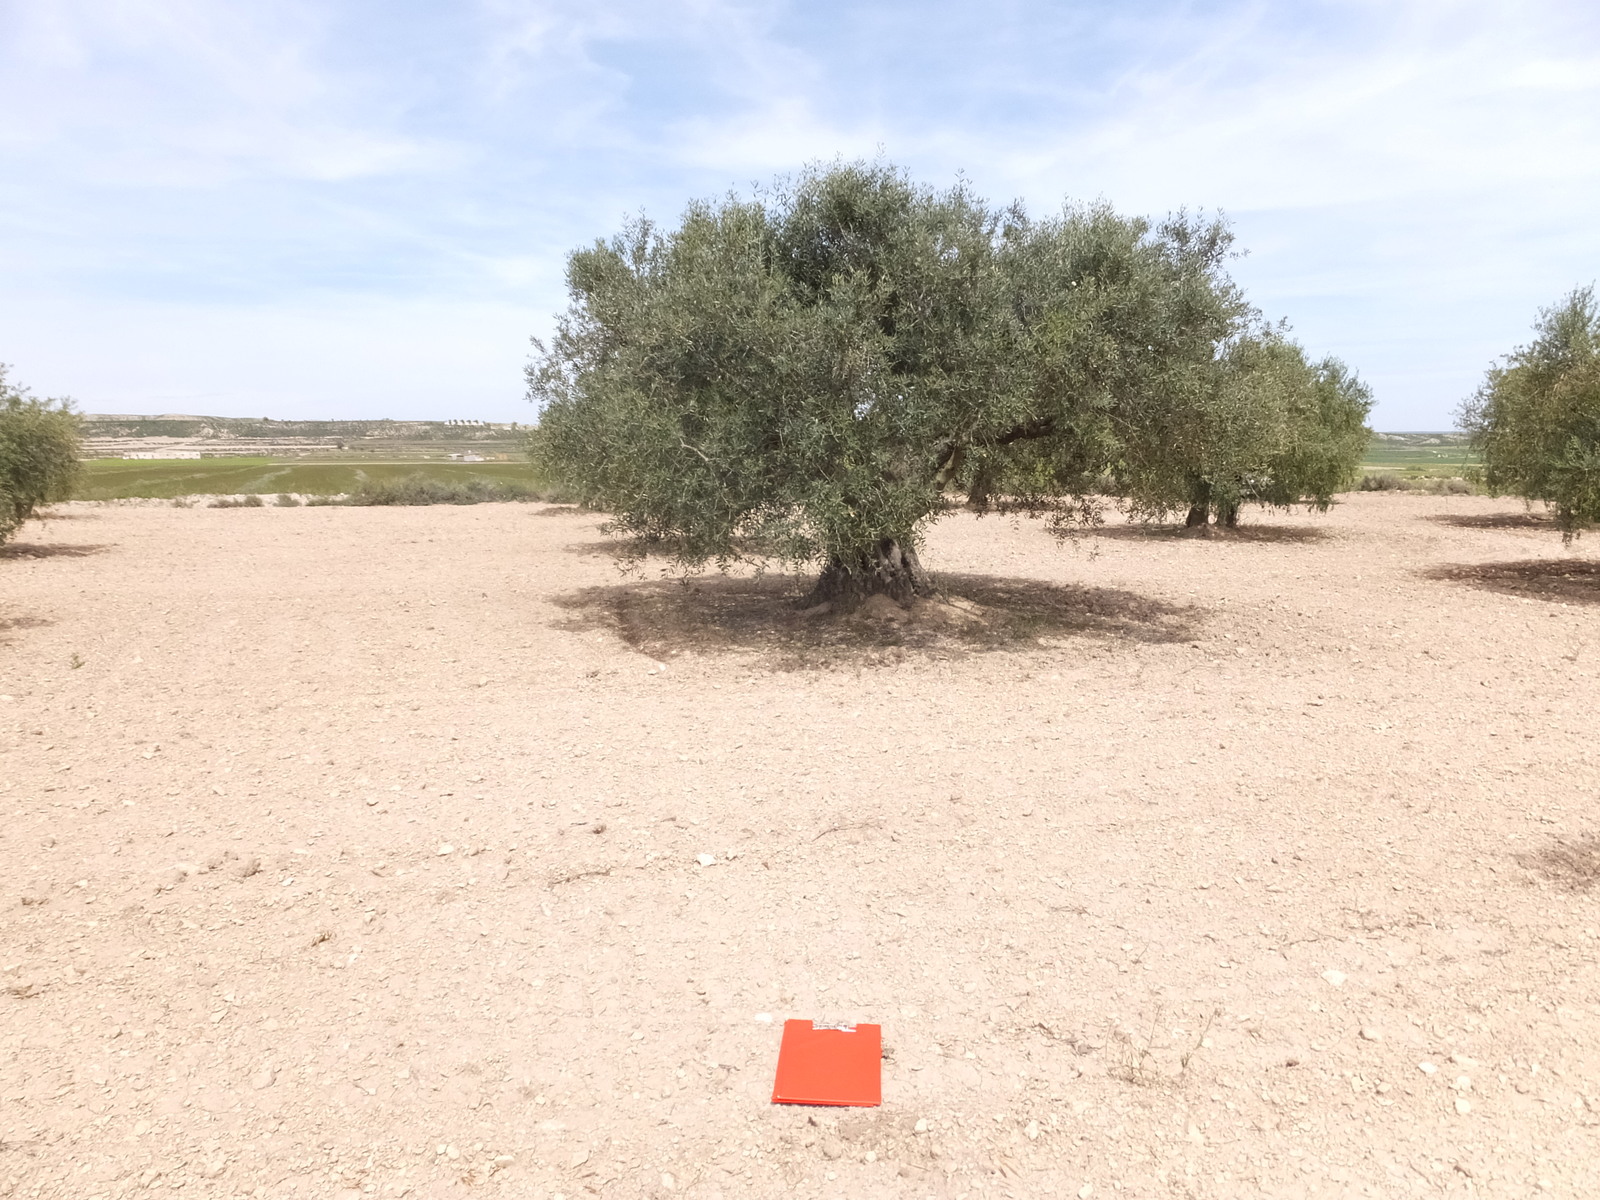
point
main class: Cropland
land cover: Olive groves
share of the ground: 10 - 25 %
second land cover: Other bare soil
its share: > 75 %
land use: Agriculture (excluding fallow land and kitchen gardens)
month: April
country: ES
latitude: 41.5918
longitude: -0.2015
